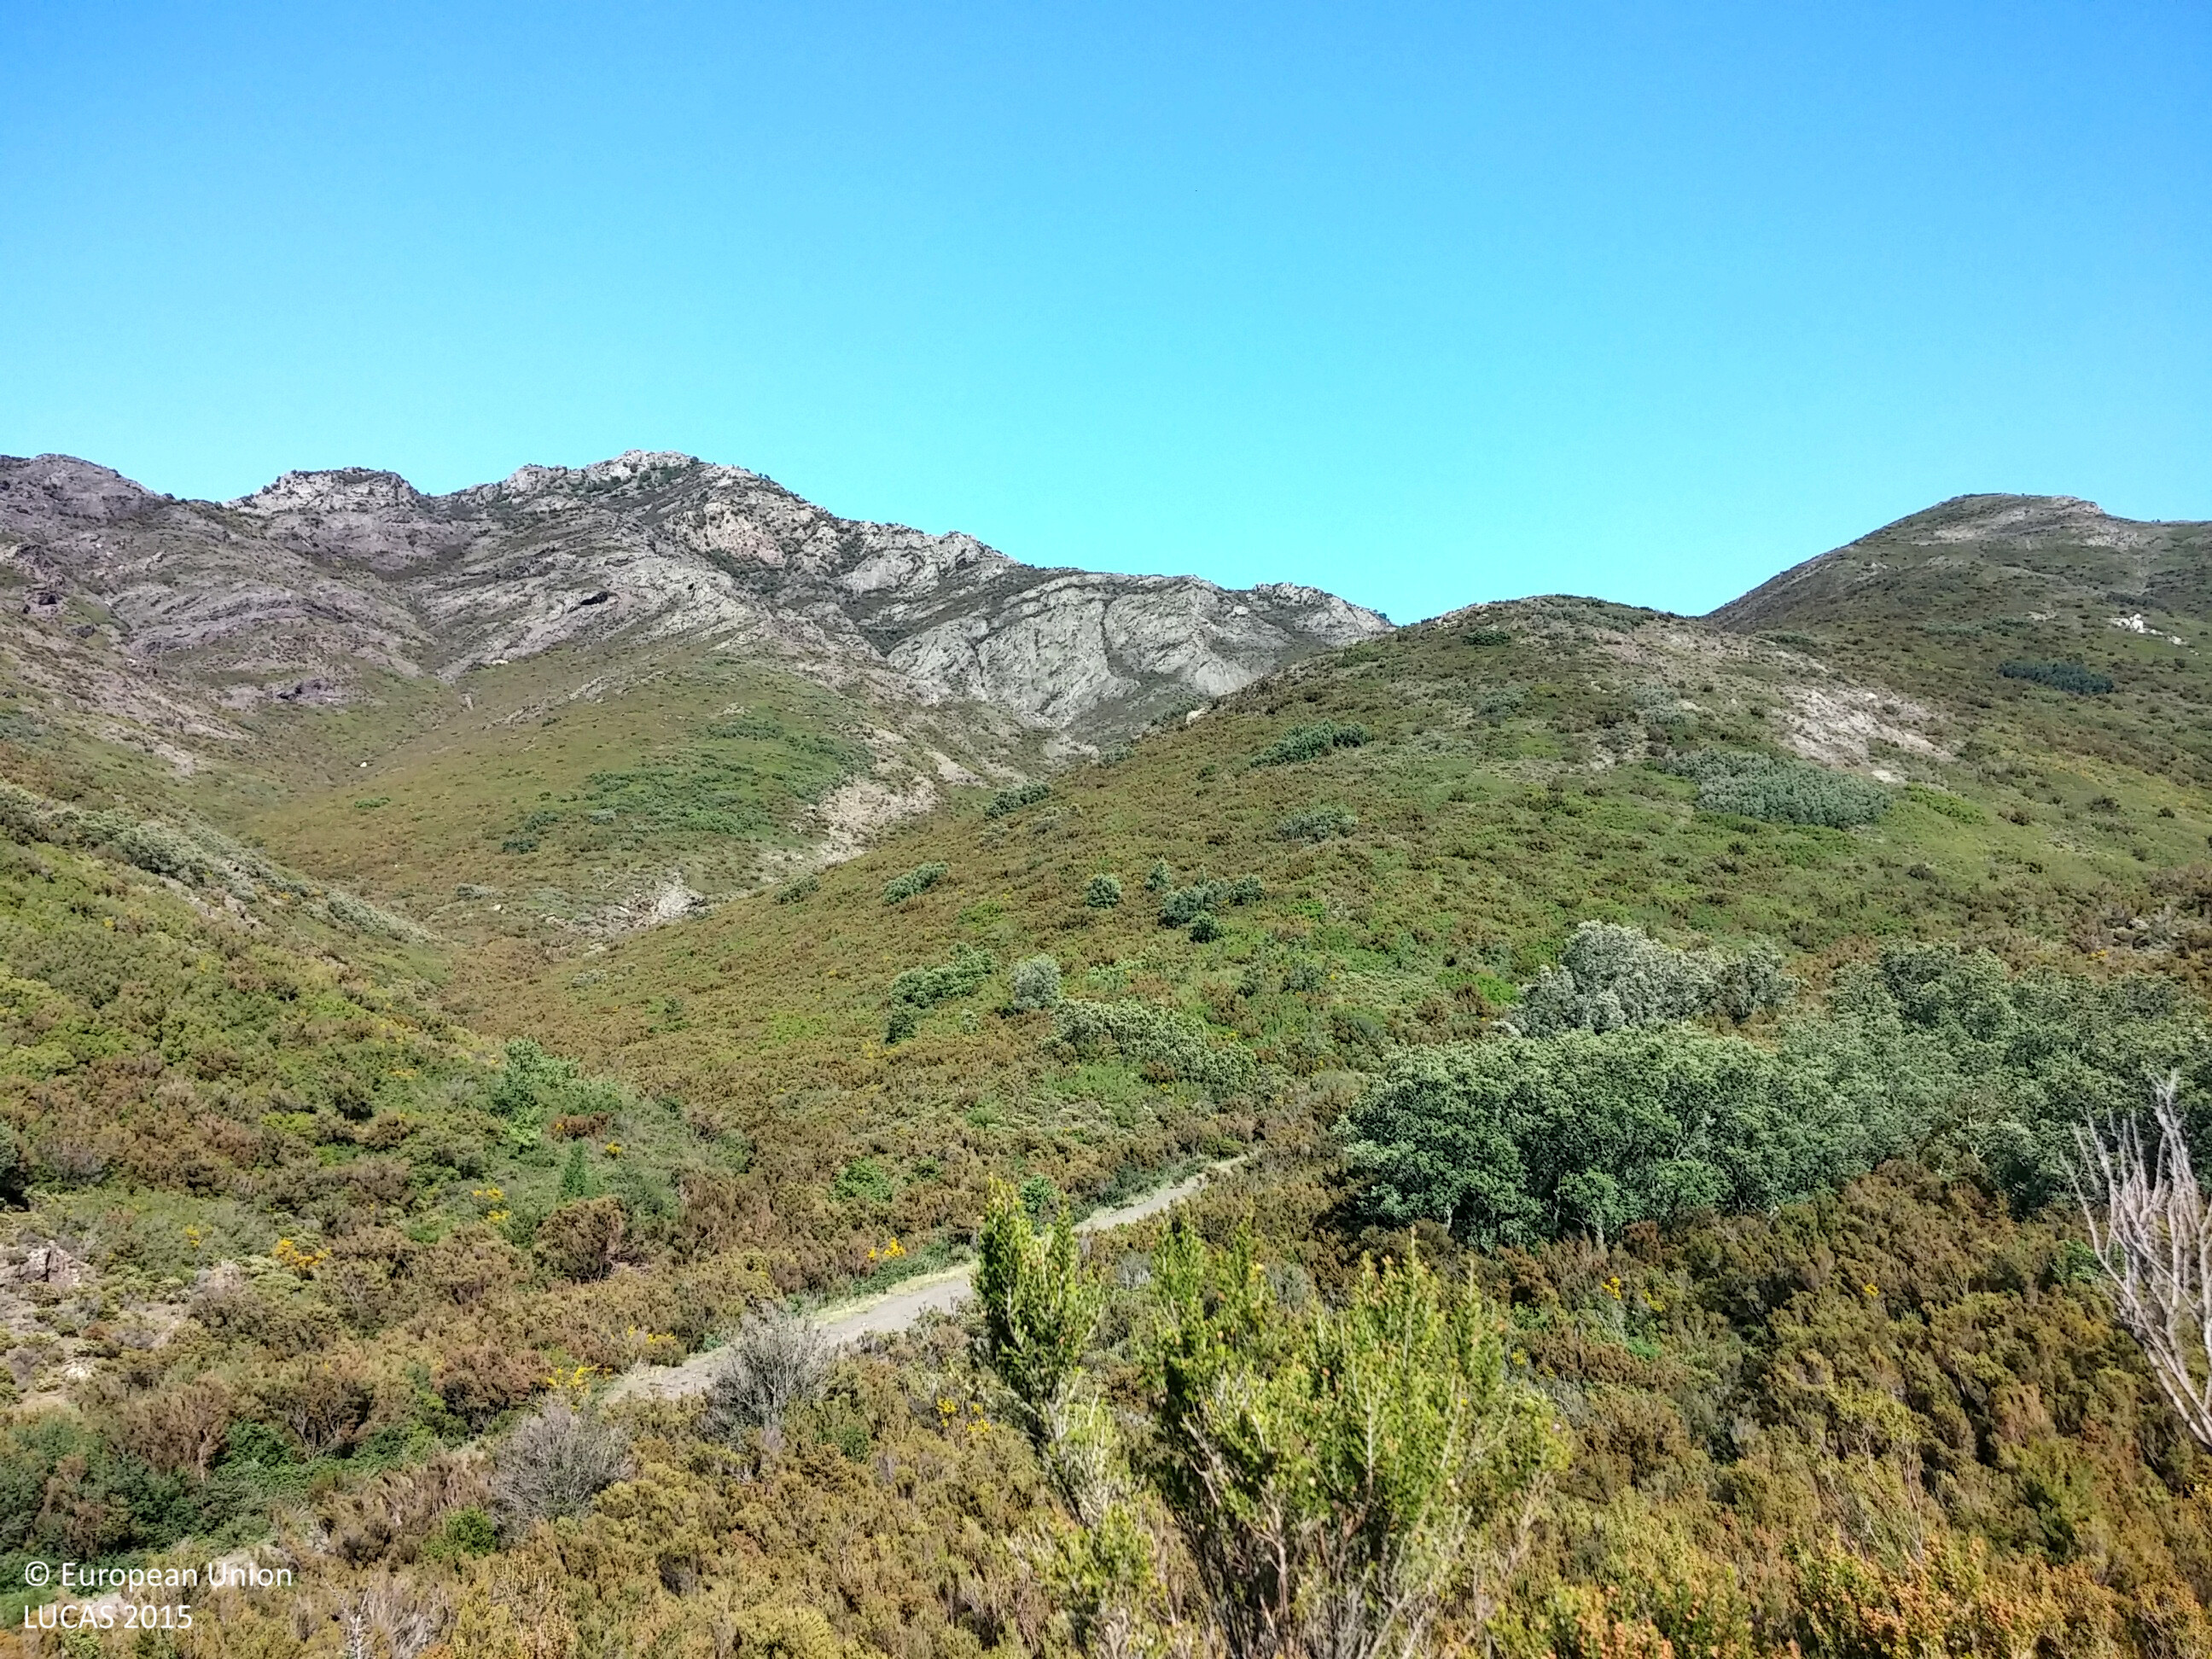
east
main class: Shrubland
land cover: Shrubland without tree cover
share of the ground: > 75 %
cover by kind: shrubs 100 %
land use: Semi-natural and natural areas not in use
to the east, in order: Shrubland without tree cover; Tracks; Shrubland with sparse tree cover; Shrubland without tree cover; Shrubland with sparse tree cover; Shrubland without tree cover; Shrubland with sparse tree cover
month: May
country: ES
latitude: 42.4331
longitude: 3.0483
